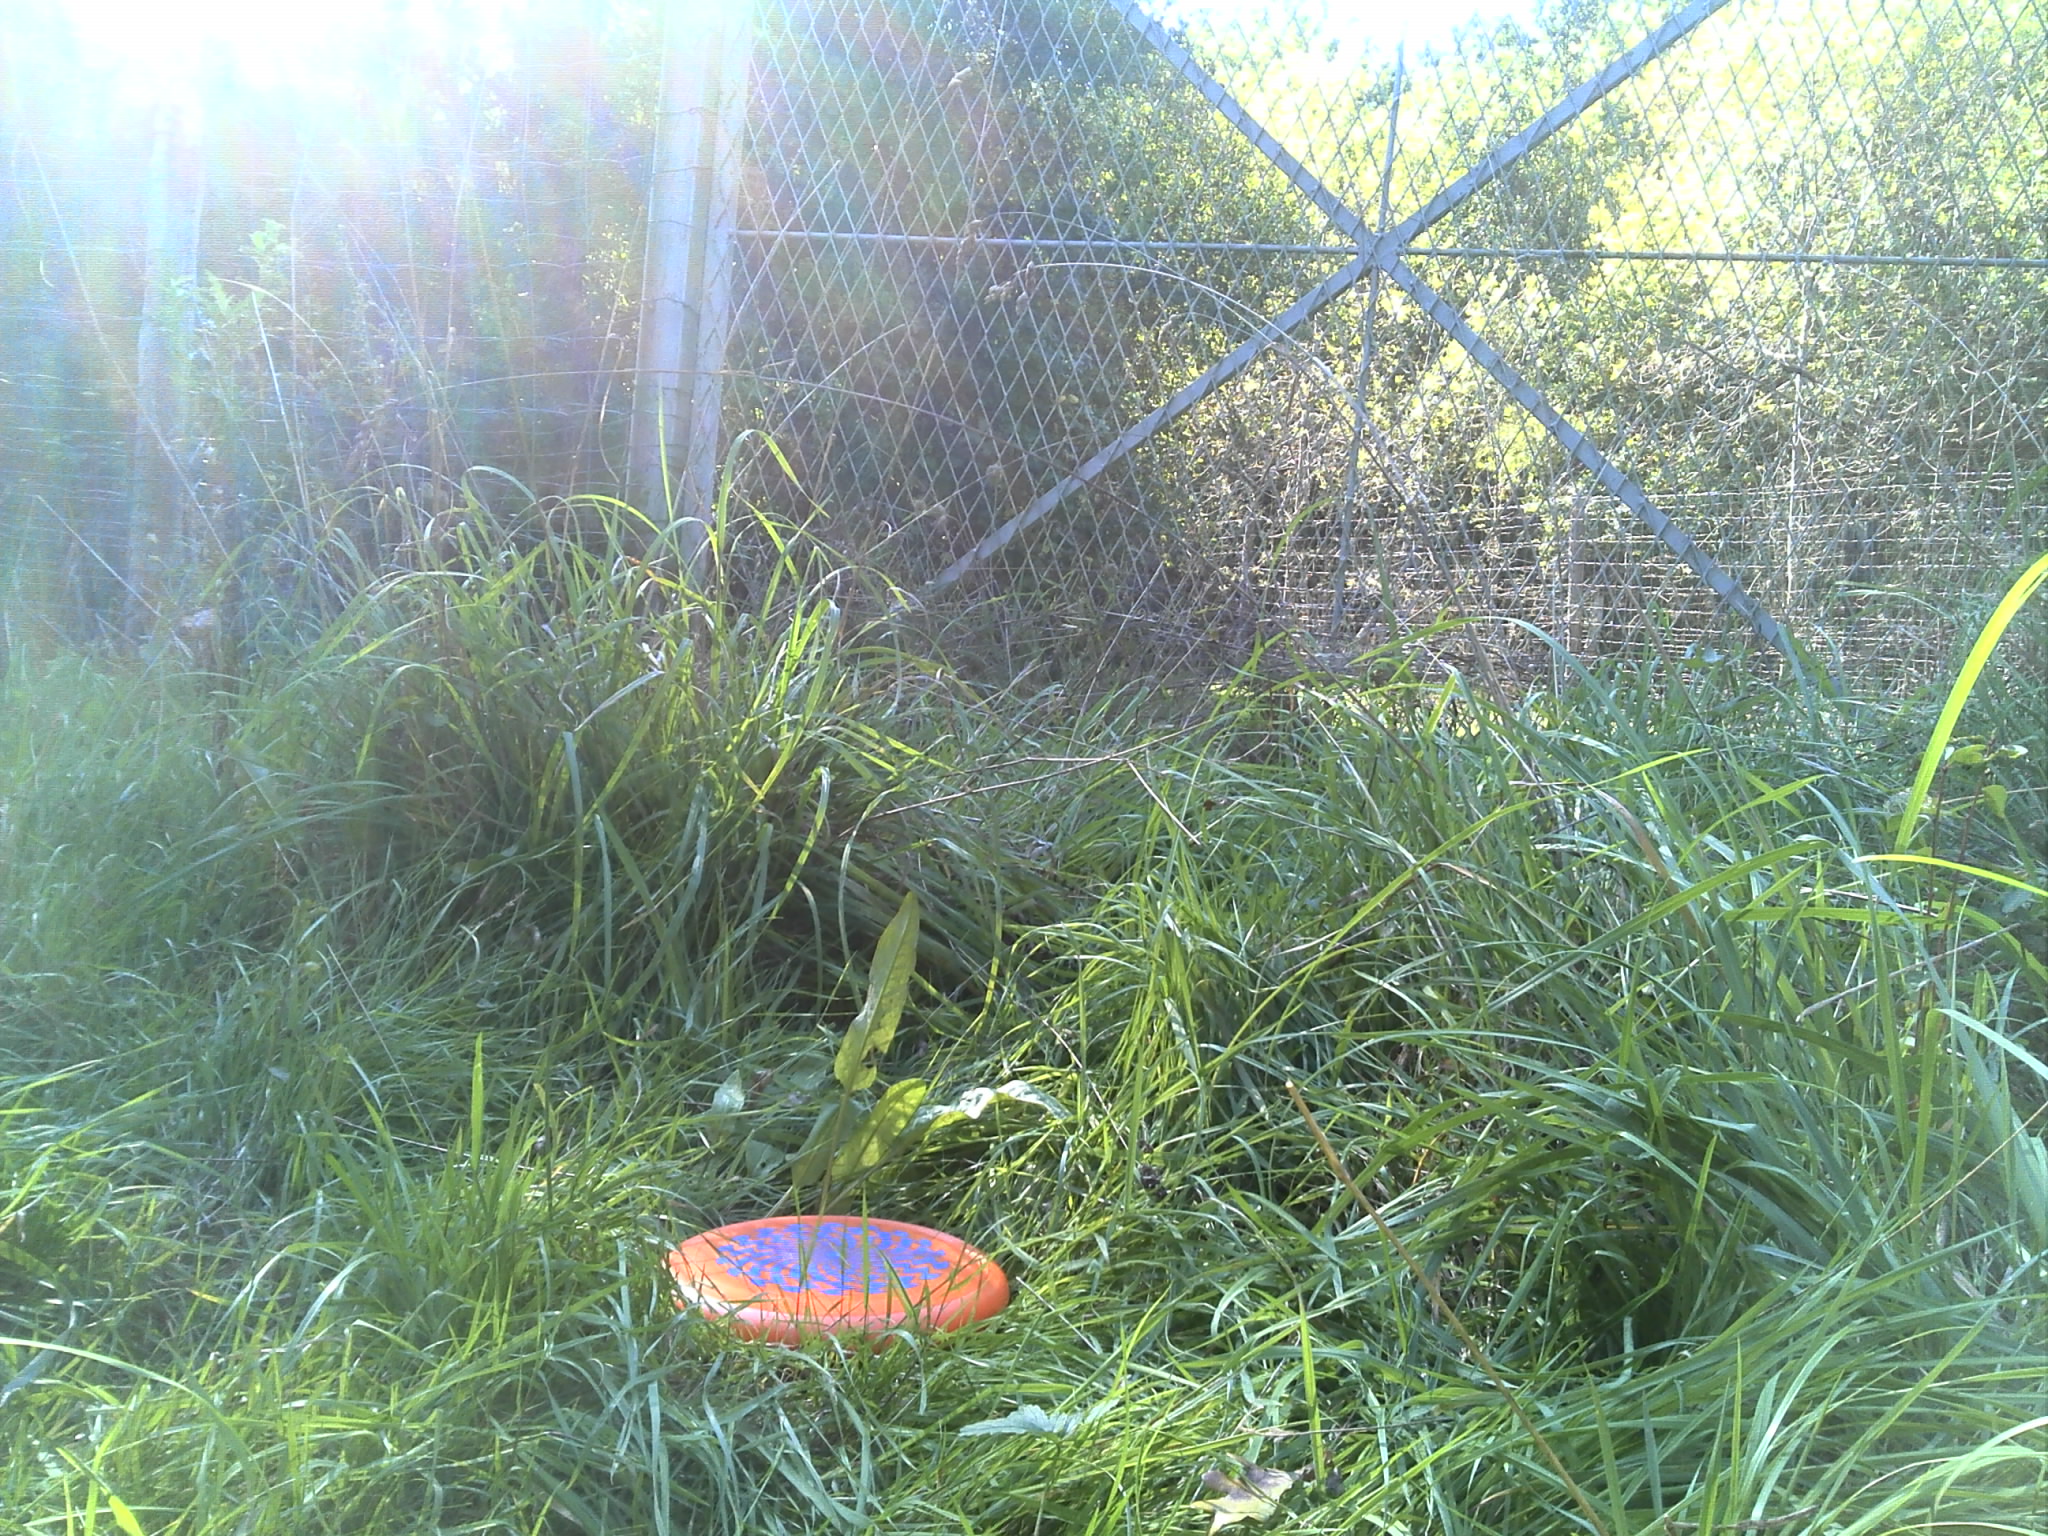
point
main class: Woodland
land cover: Broadleaved woodland
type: mesophytic deciduous forest
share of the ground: > 75 %
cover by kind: broadleaved forest trees 90 %, herbaceous plants 10 %
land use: Forestry
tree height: > 5 m
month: October
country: FR
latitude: 47.5061
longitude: -1.0167
